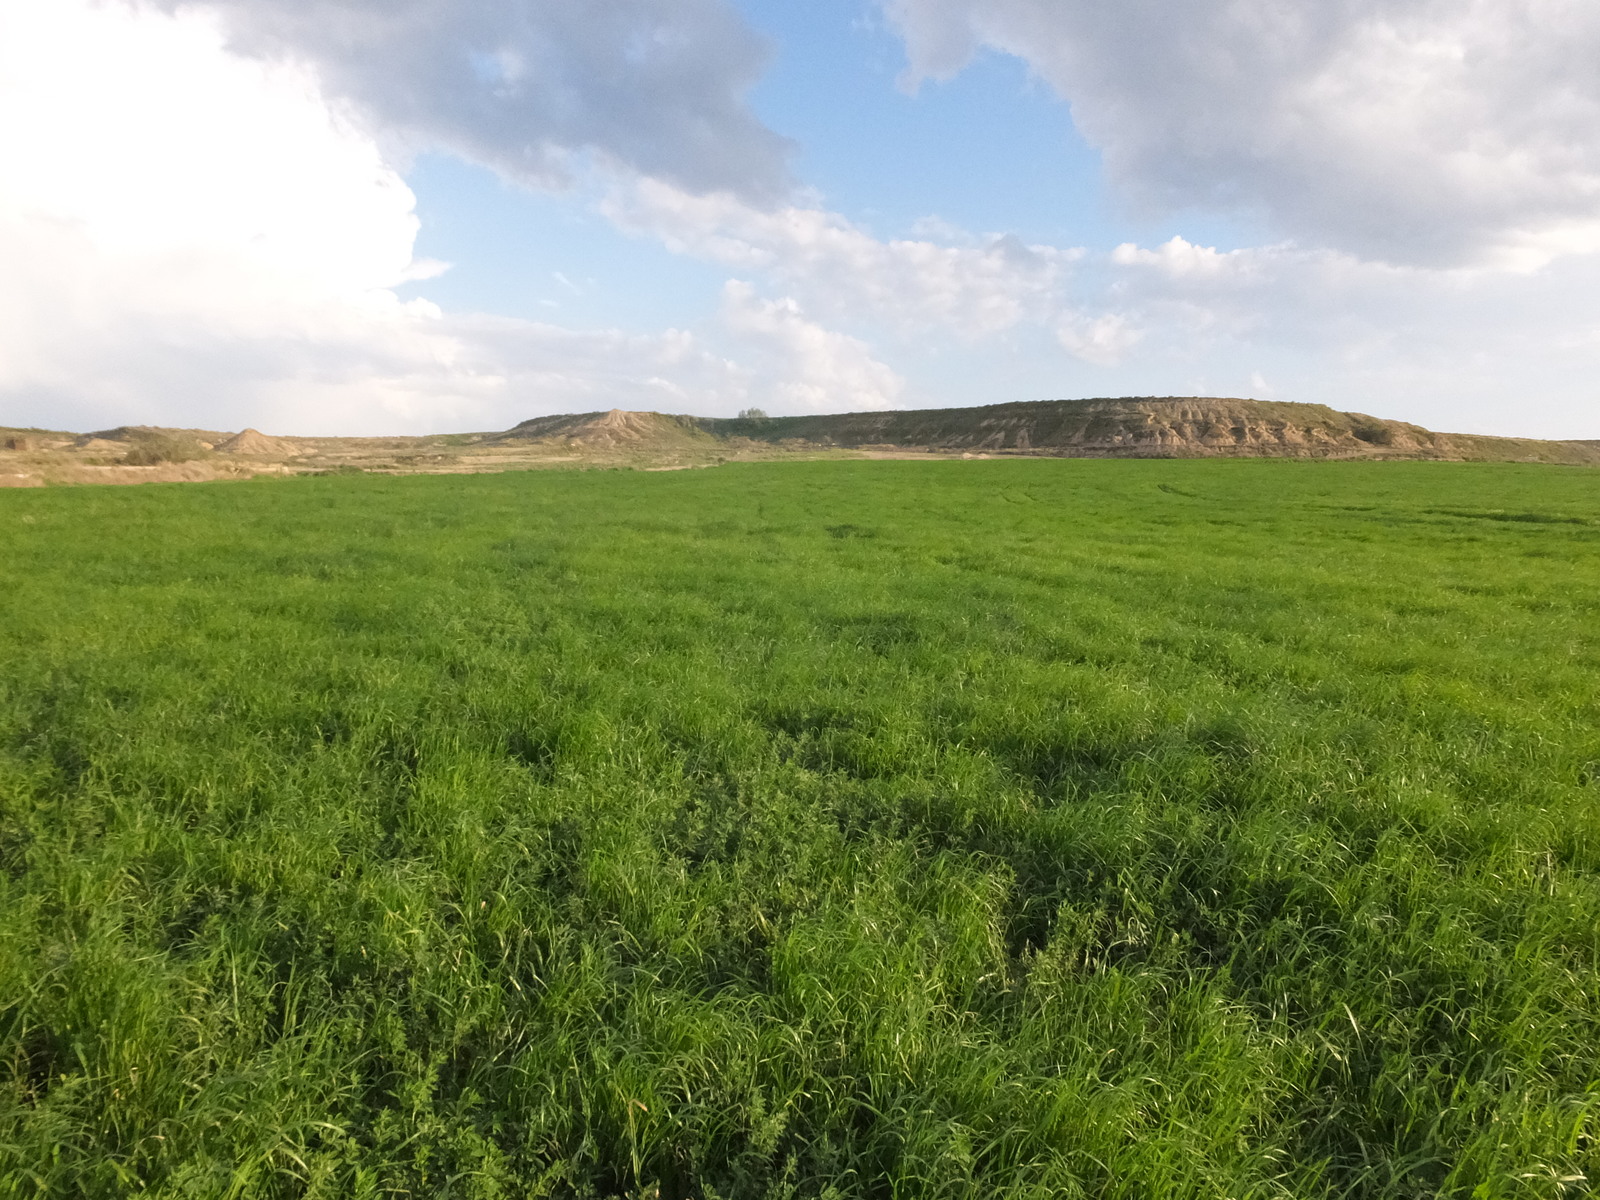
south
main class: Cropland
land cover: Other leguminous and mixtures for fodder
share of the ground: > 75 %
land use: Agriculture (excluding fallow land and kitchen gardens)
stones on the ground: < 10 %
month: April
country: ES
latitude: 41.7609
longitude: -0.3267
